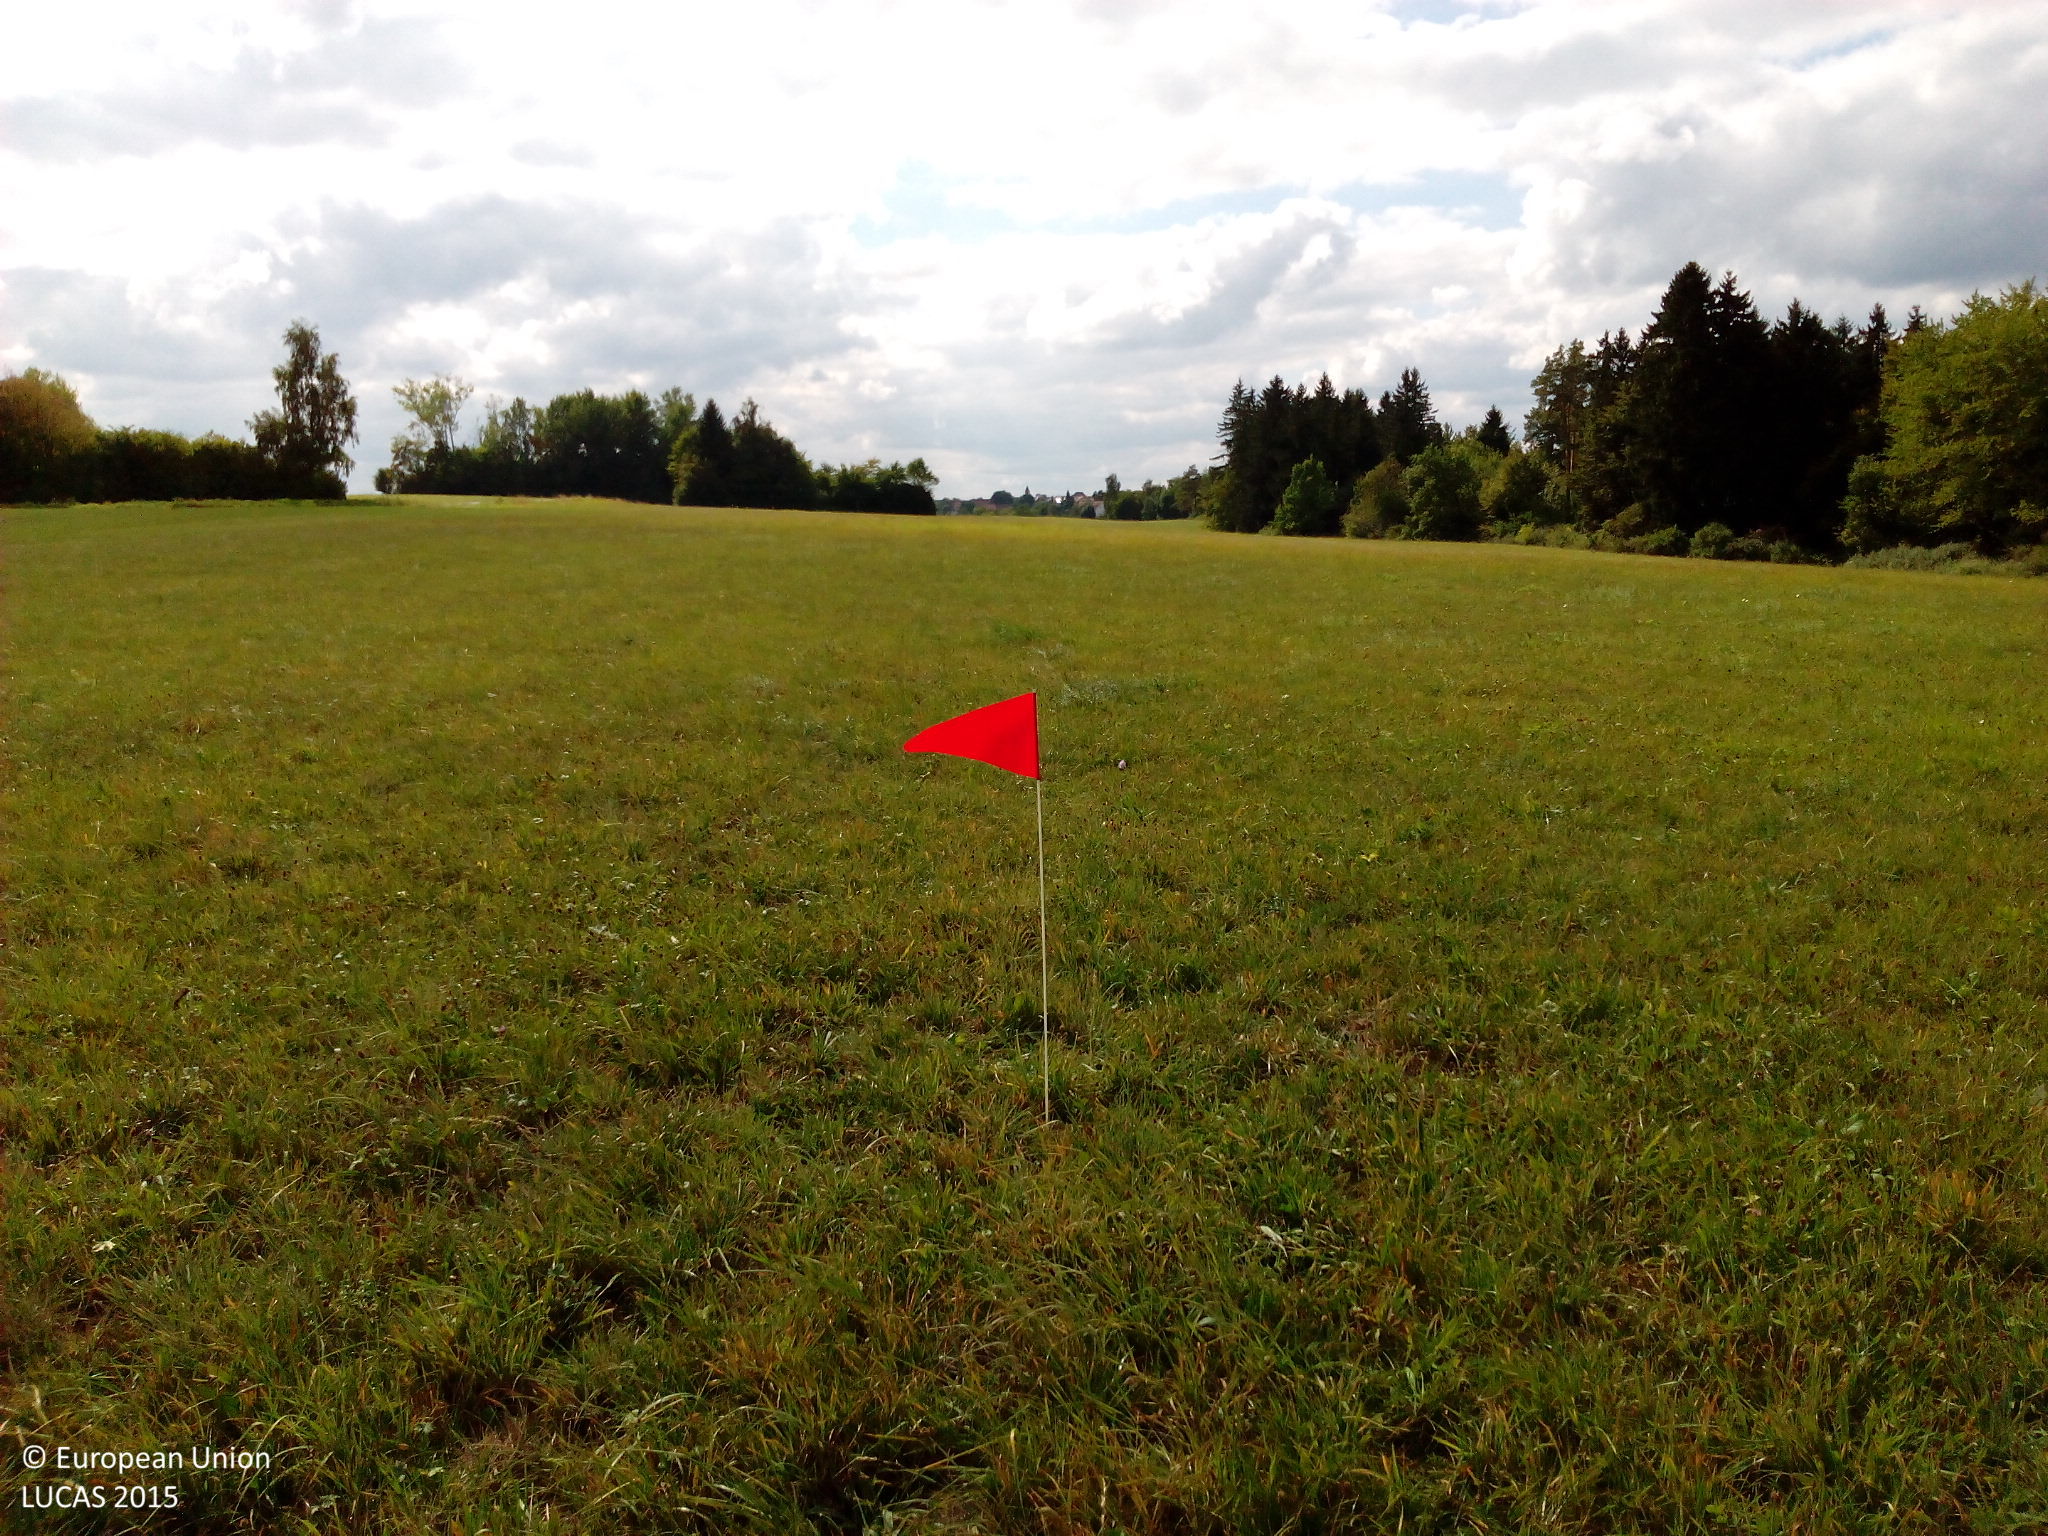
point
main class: Grassland
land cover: Grassland without tree/shrub cover
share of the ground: > 75 %
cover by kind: herbaceous plants 95 %, unconsolidated bare surface 5 %
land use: Agriculture (excluding fallow land and kitchen gardens)
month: September
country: DE
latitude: 48.2861
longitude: 8.5587
